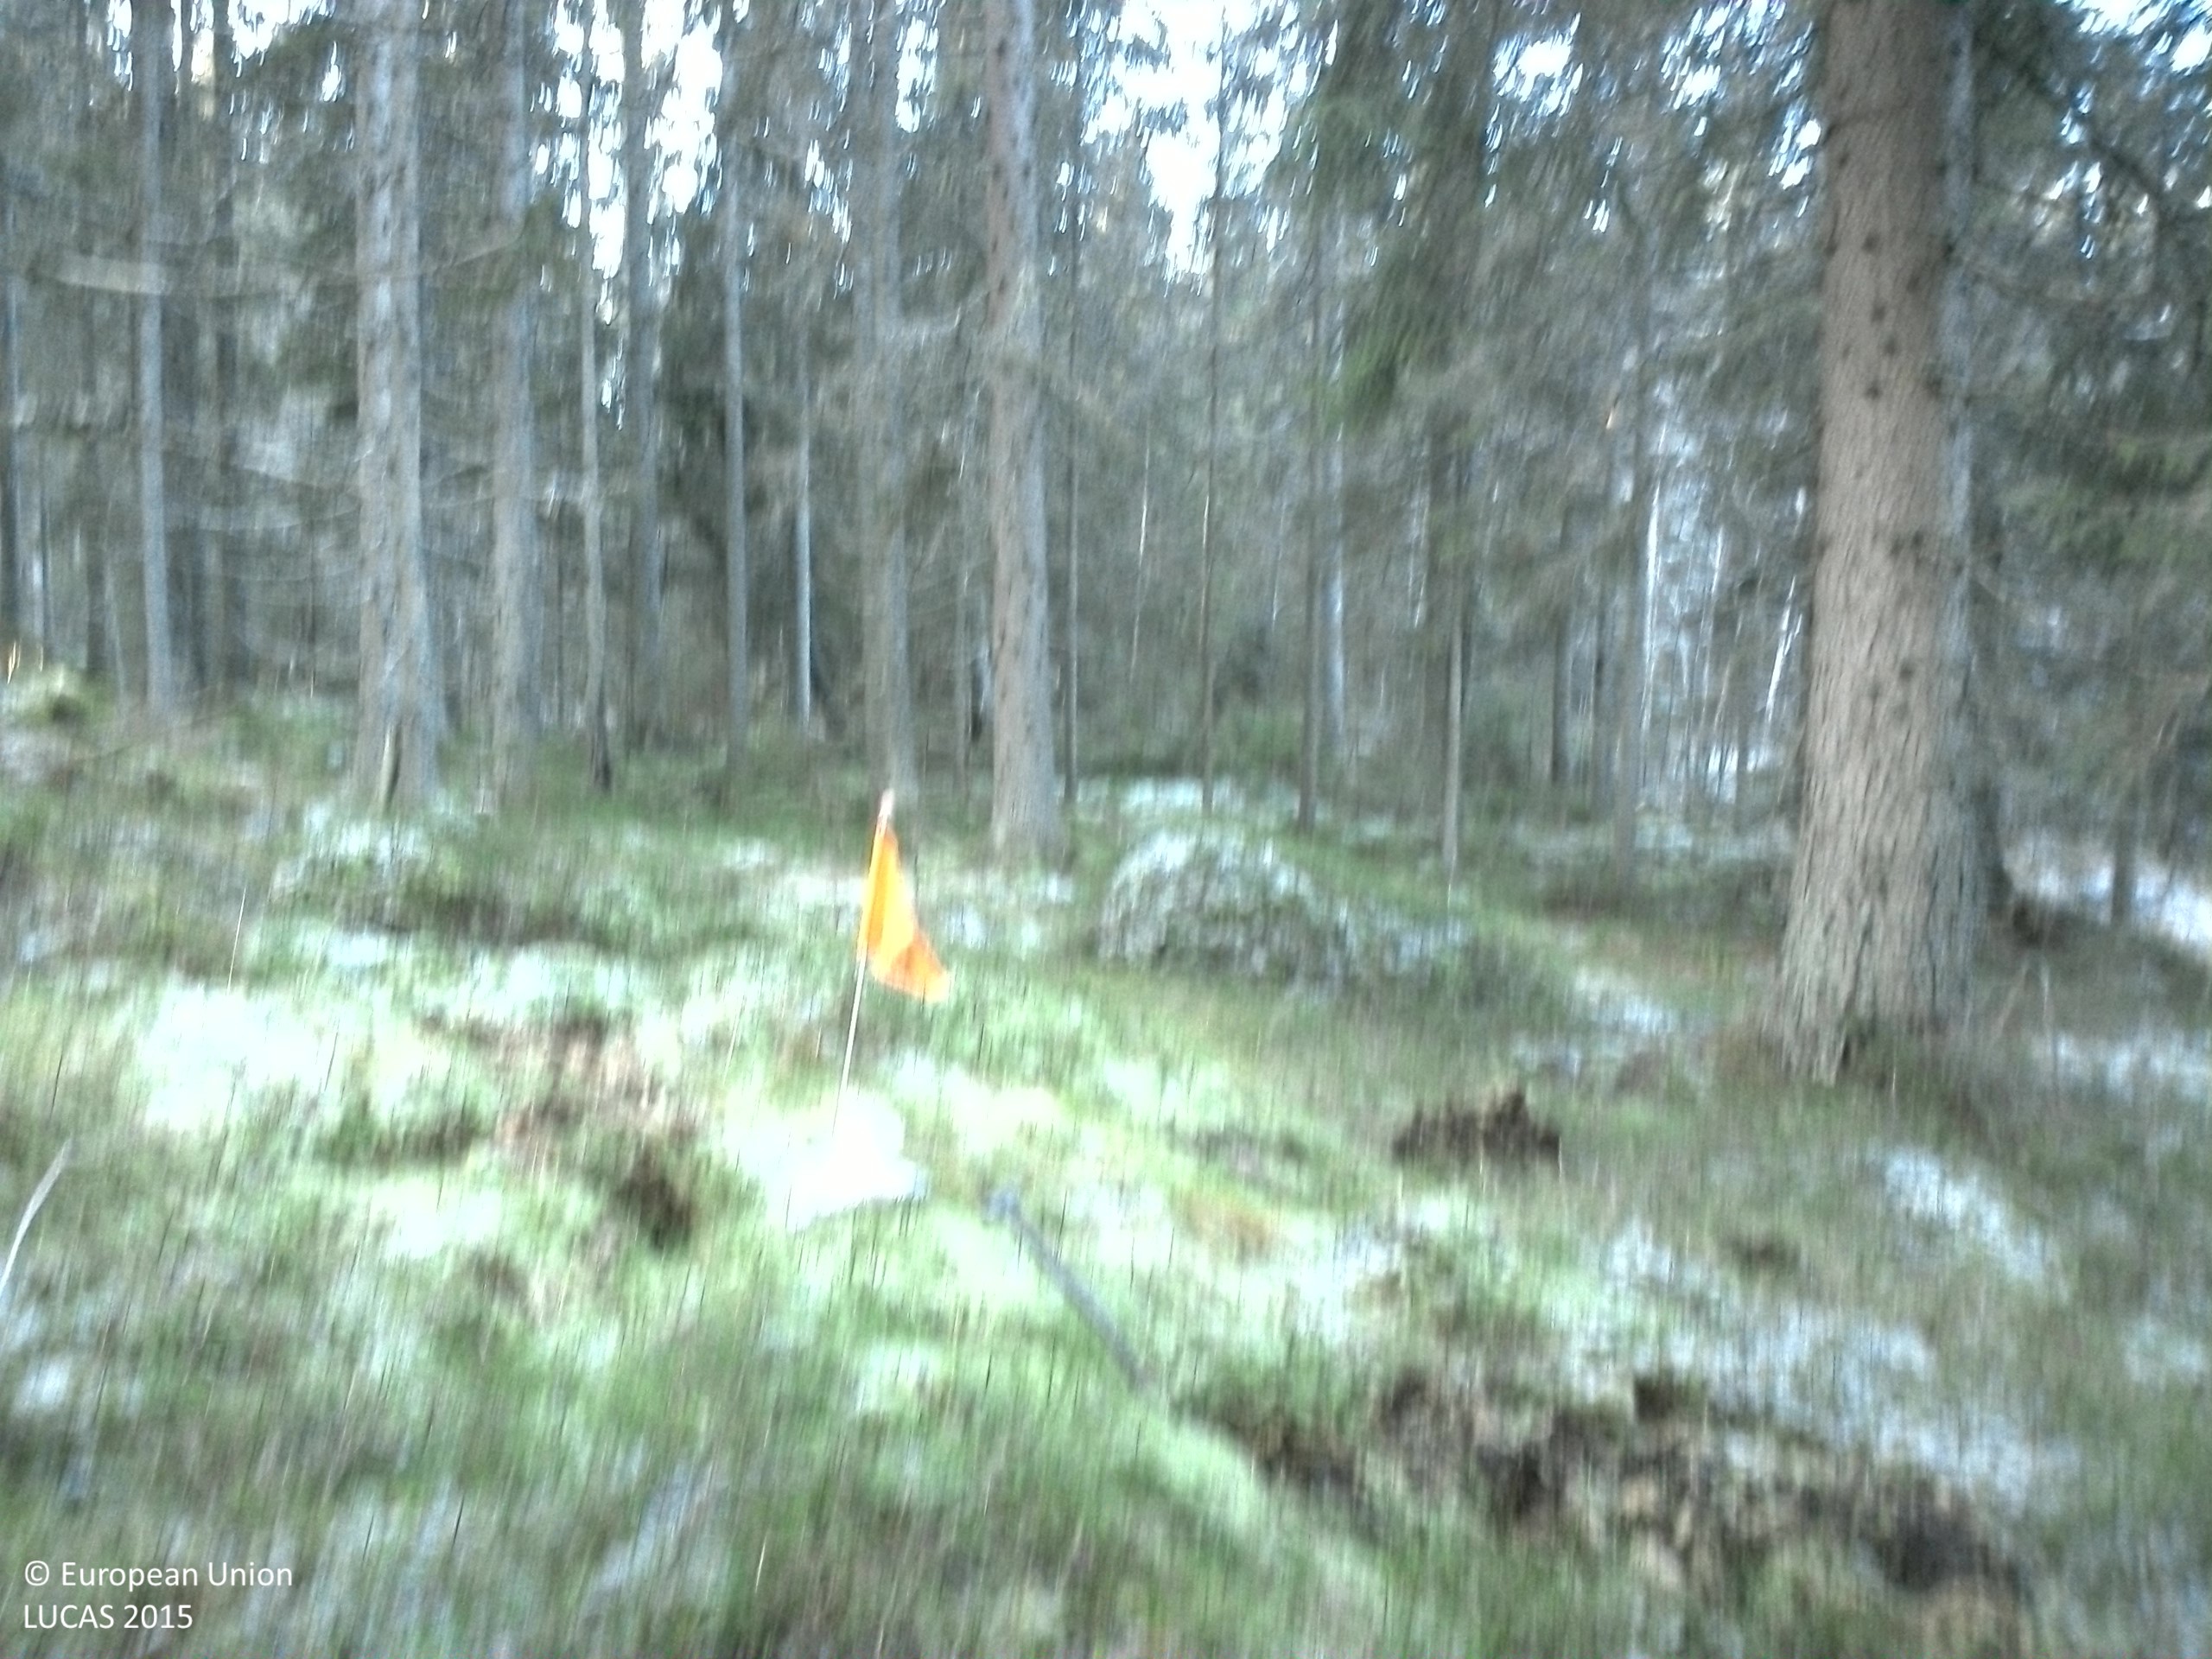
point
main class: Woodland
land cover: Spruce dominated coniferous woodland
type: boreal forest
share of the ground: > 75 %
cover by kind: coniferous forest trees 75 %, shrubs 15 %, lichens and mosses 10 %
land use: Forestry
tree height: > 5 m
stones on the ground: 10 - 25 %
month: November
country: SE
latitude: 60.3007
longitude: 15.6883
